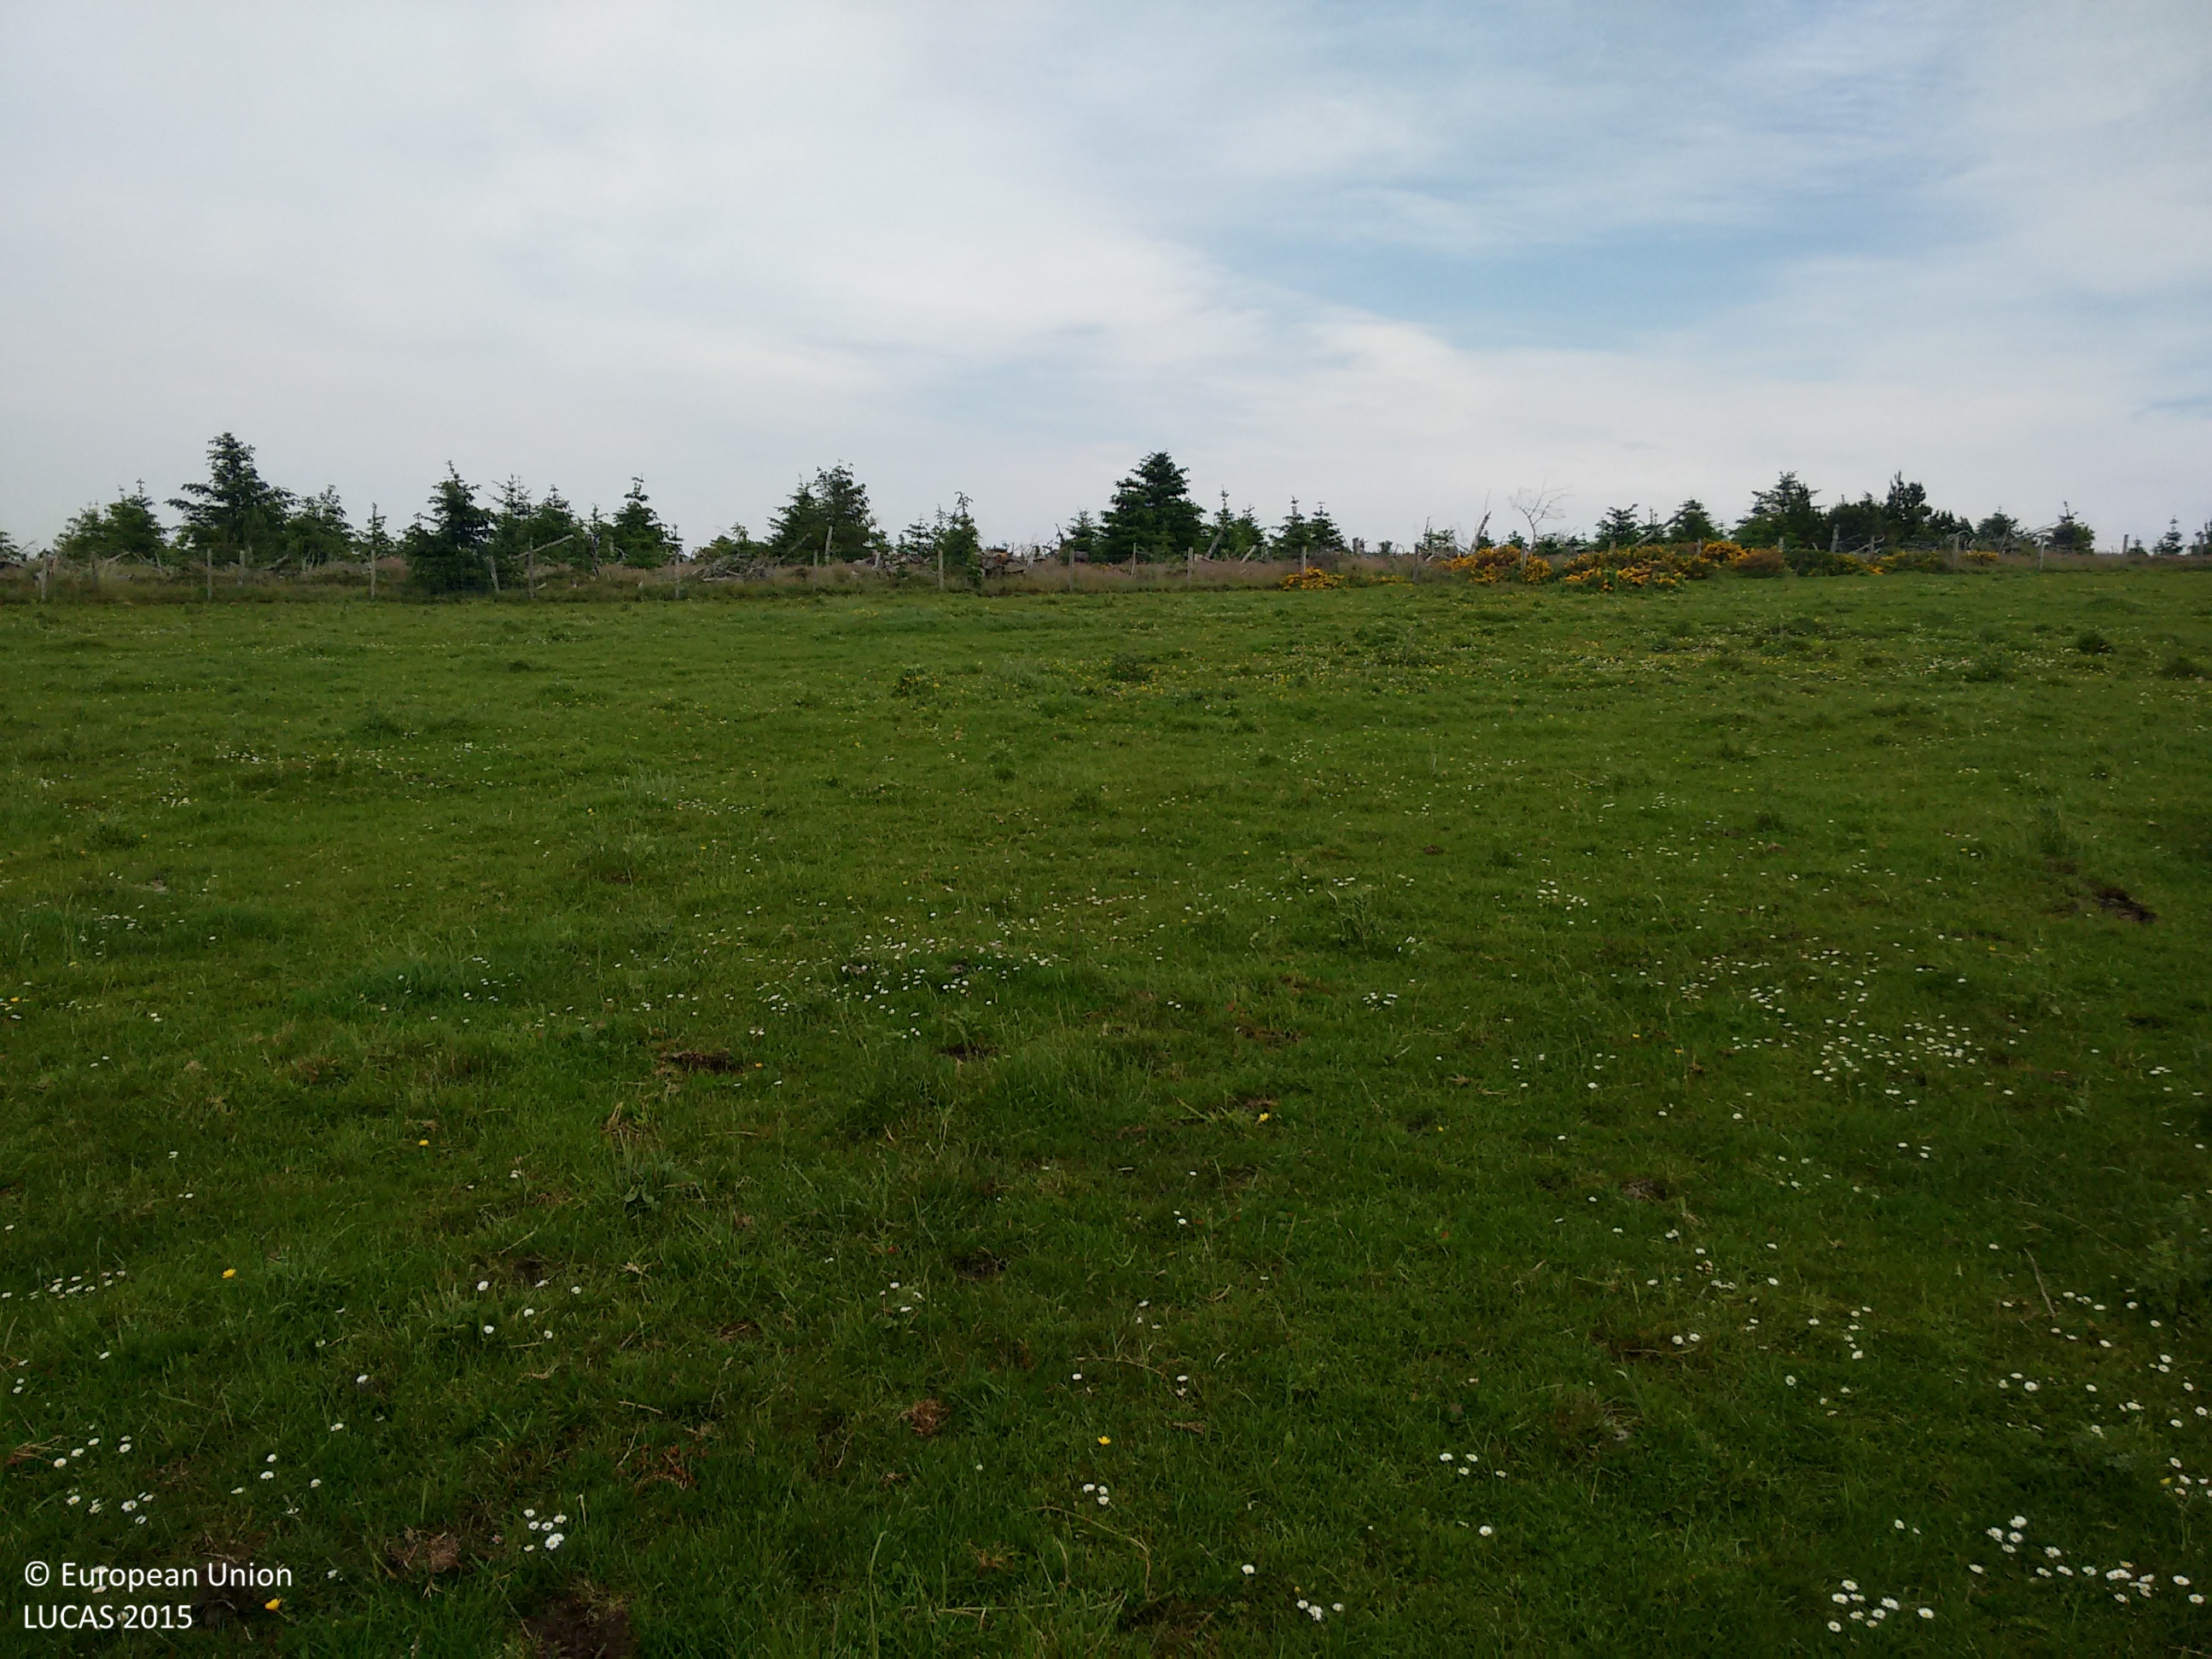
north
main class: Grassland
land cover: Grassland without tree/shrub cover
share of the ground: > 75 %
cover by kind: herbaceous plants 100 %
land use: Agriculture (excluding fallow land and kitchen gardens)
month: July
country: GB
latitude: 57.4156
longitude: -2.8621
